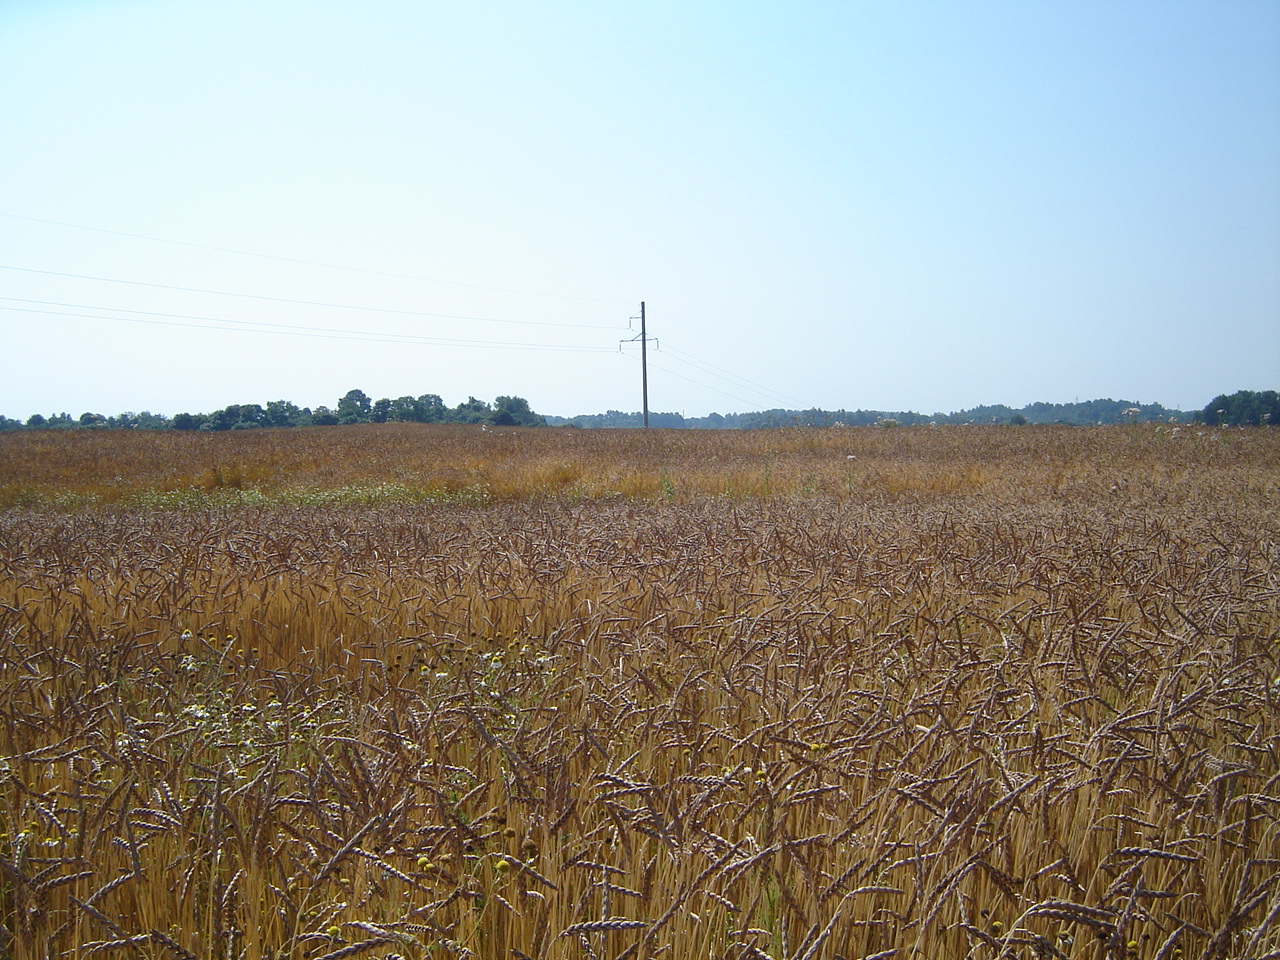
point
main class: Cropland
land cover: Common wheat
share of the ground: > 75 %
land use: Agriculture (excluding fallow land and kitchen gardens)
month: August
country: LT
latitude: 55.0752
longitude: 25.3296
